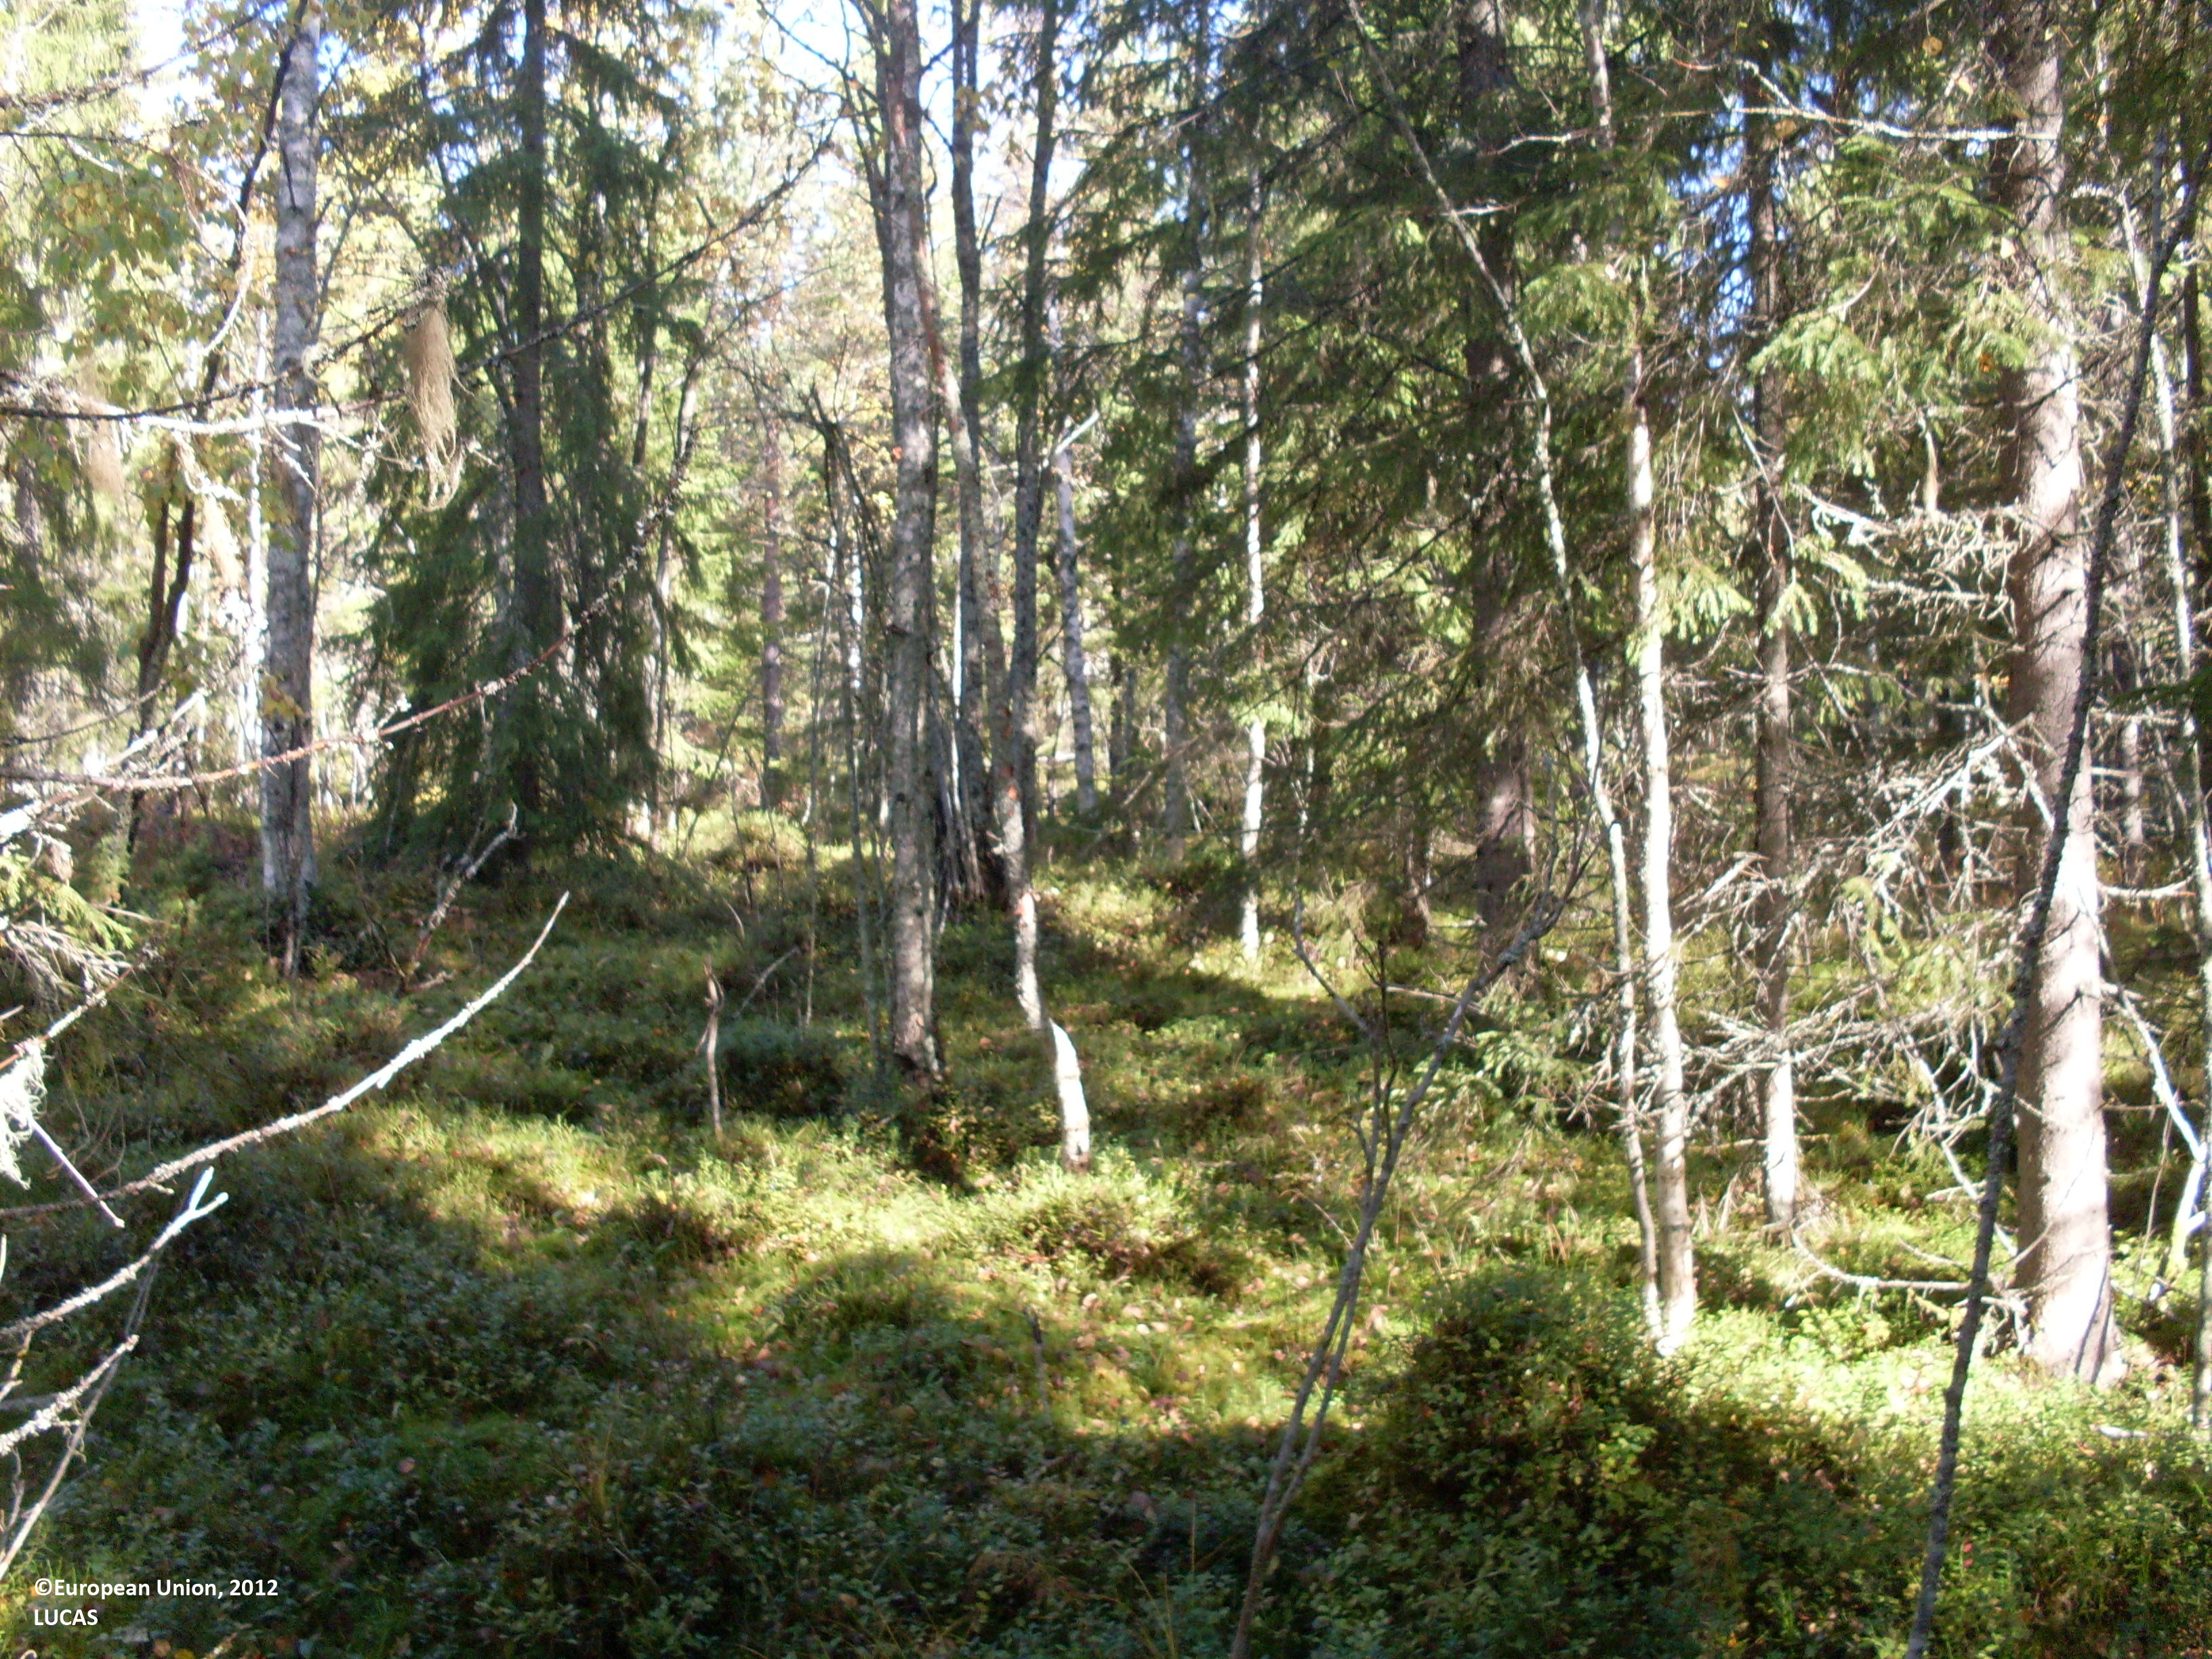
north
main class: Woodland
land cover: Spruce dominated mixed woodland
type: boreal forest
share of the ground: > 75 %
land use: Forestry
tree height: > 5 m
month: September
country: FI
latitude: 64.3326
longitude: 28.4047
